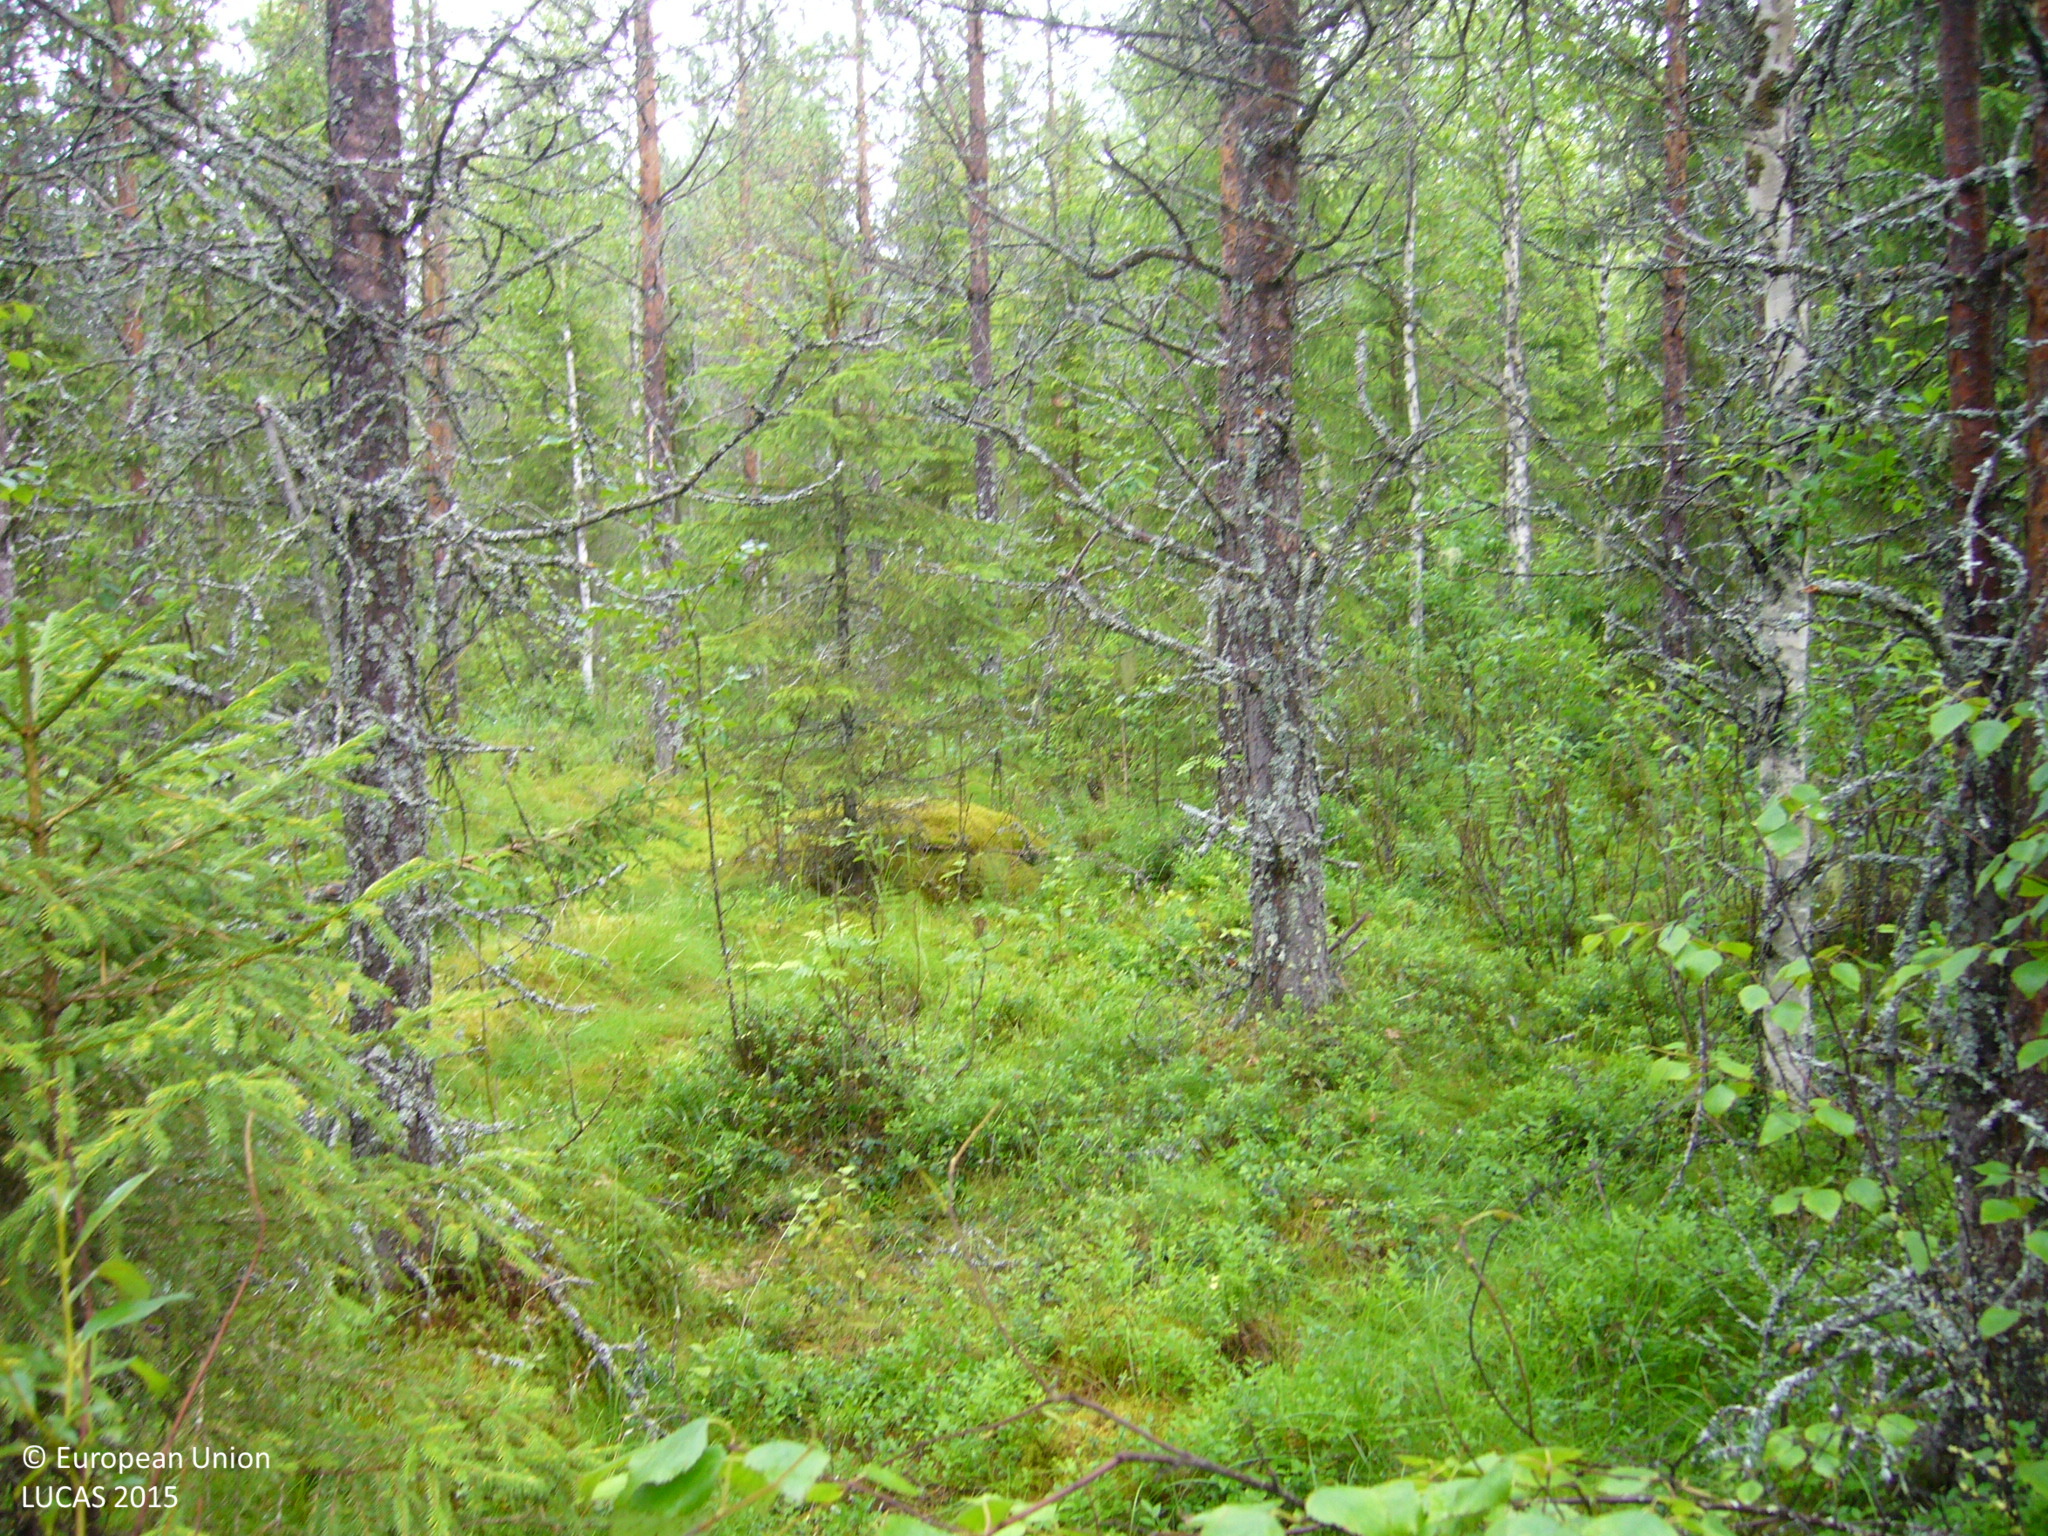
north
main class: Woodland
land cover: Pine dominated mixed woodland
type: boreal forest
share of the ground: > 75 %
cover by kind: coniferous forest trees 50 %, broadleaved forest trees 25 %, shrubs 25 %
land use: Forestry
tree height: > 5 m
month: July
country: FI
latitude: 63.8523
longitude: 26.0355
